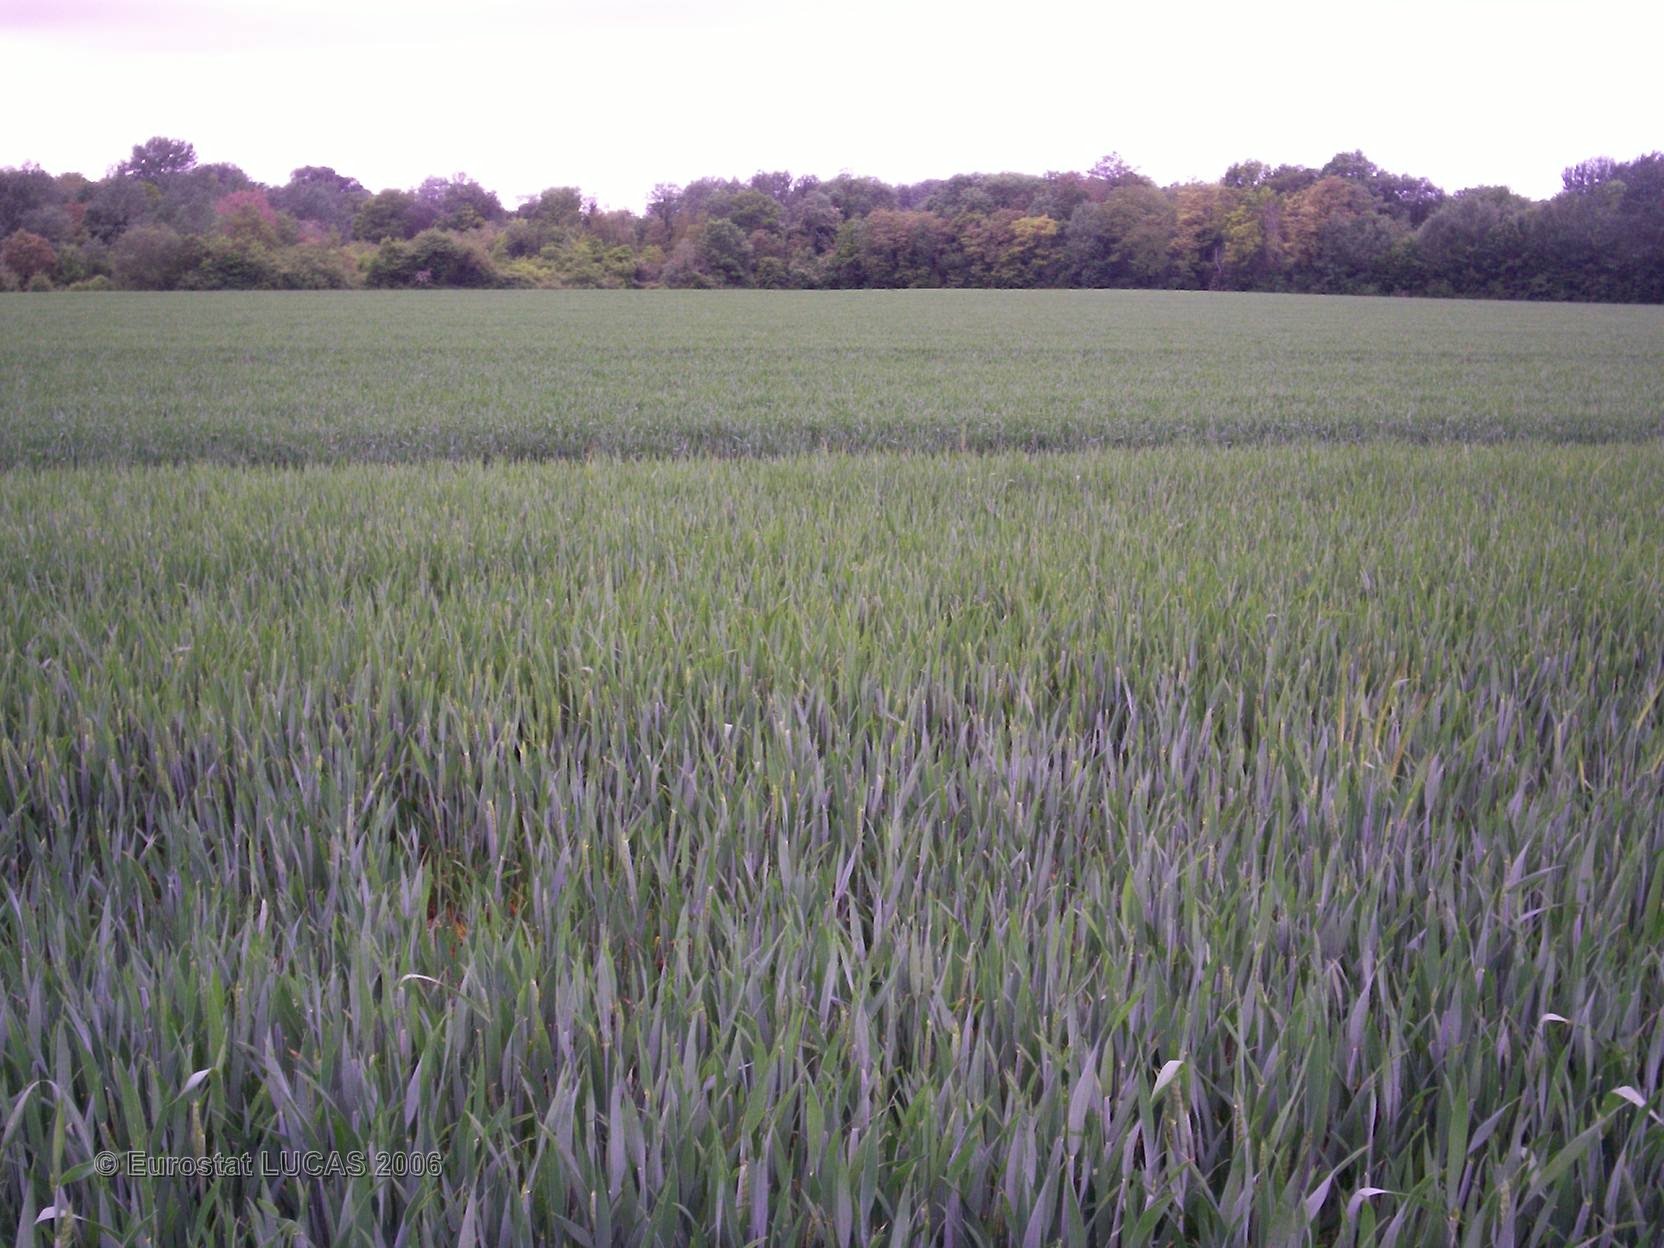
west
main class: Cropland
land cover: Common wheat
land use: Agriculture (excluding fallow land and kitchen gardens)
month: May
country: FR
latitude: 48.3584
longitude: 4.5316
